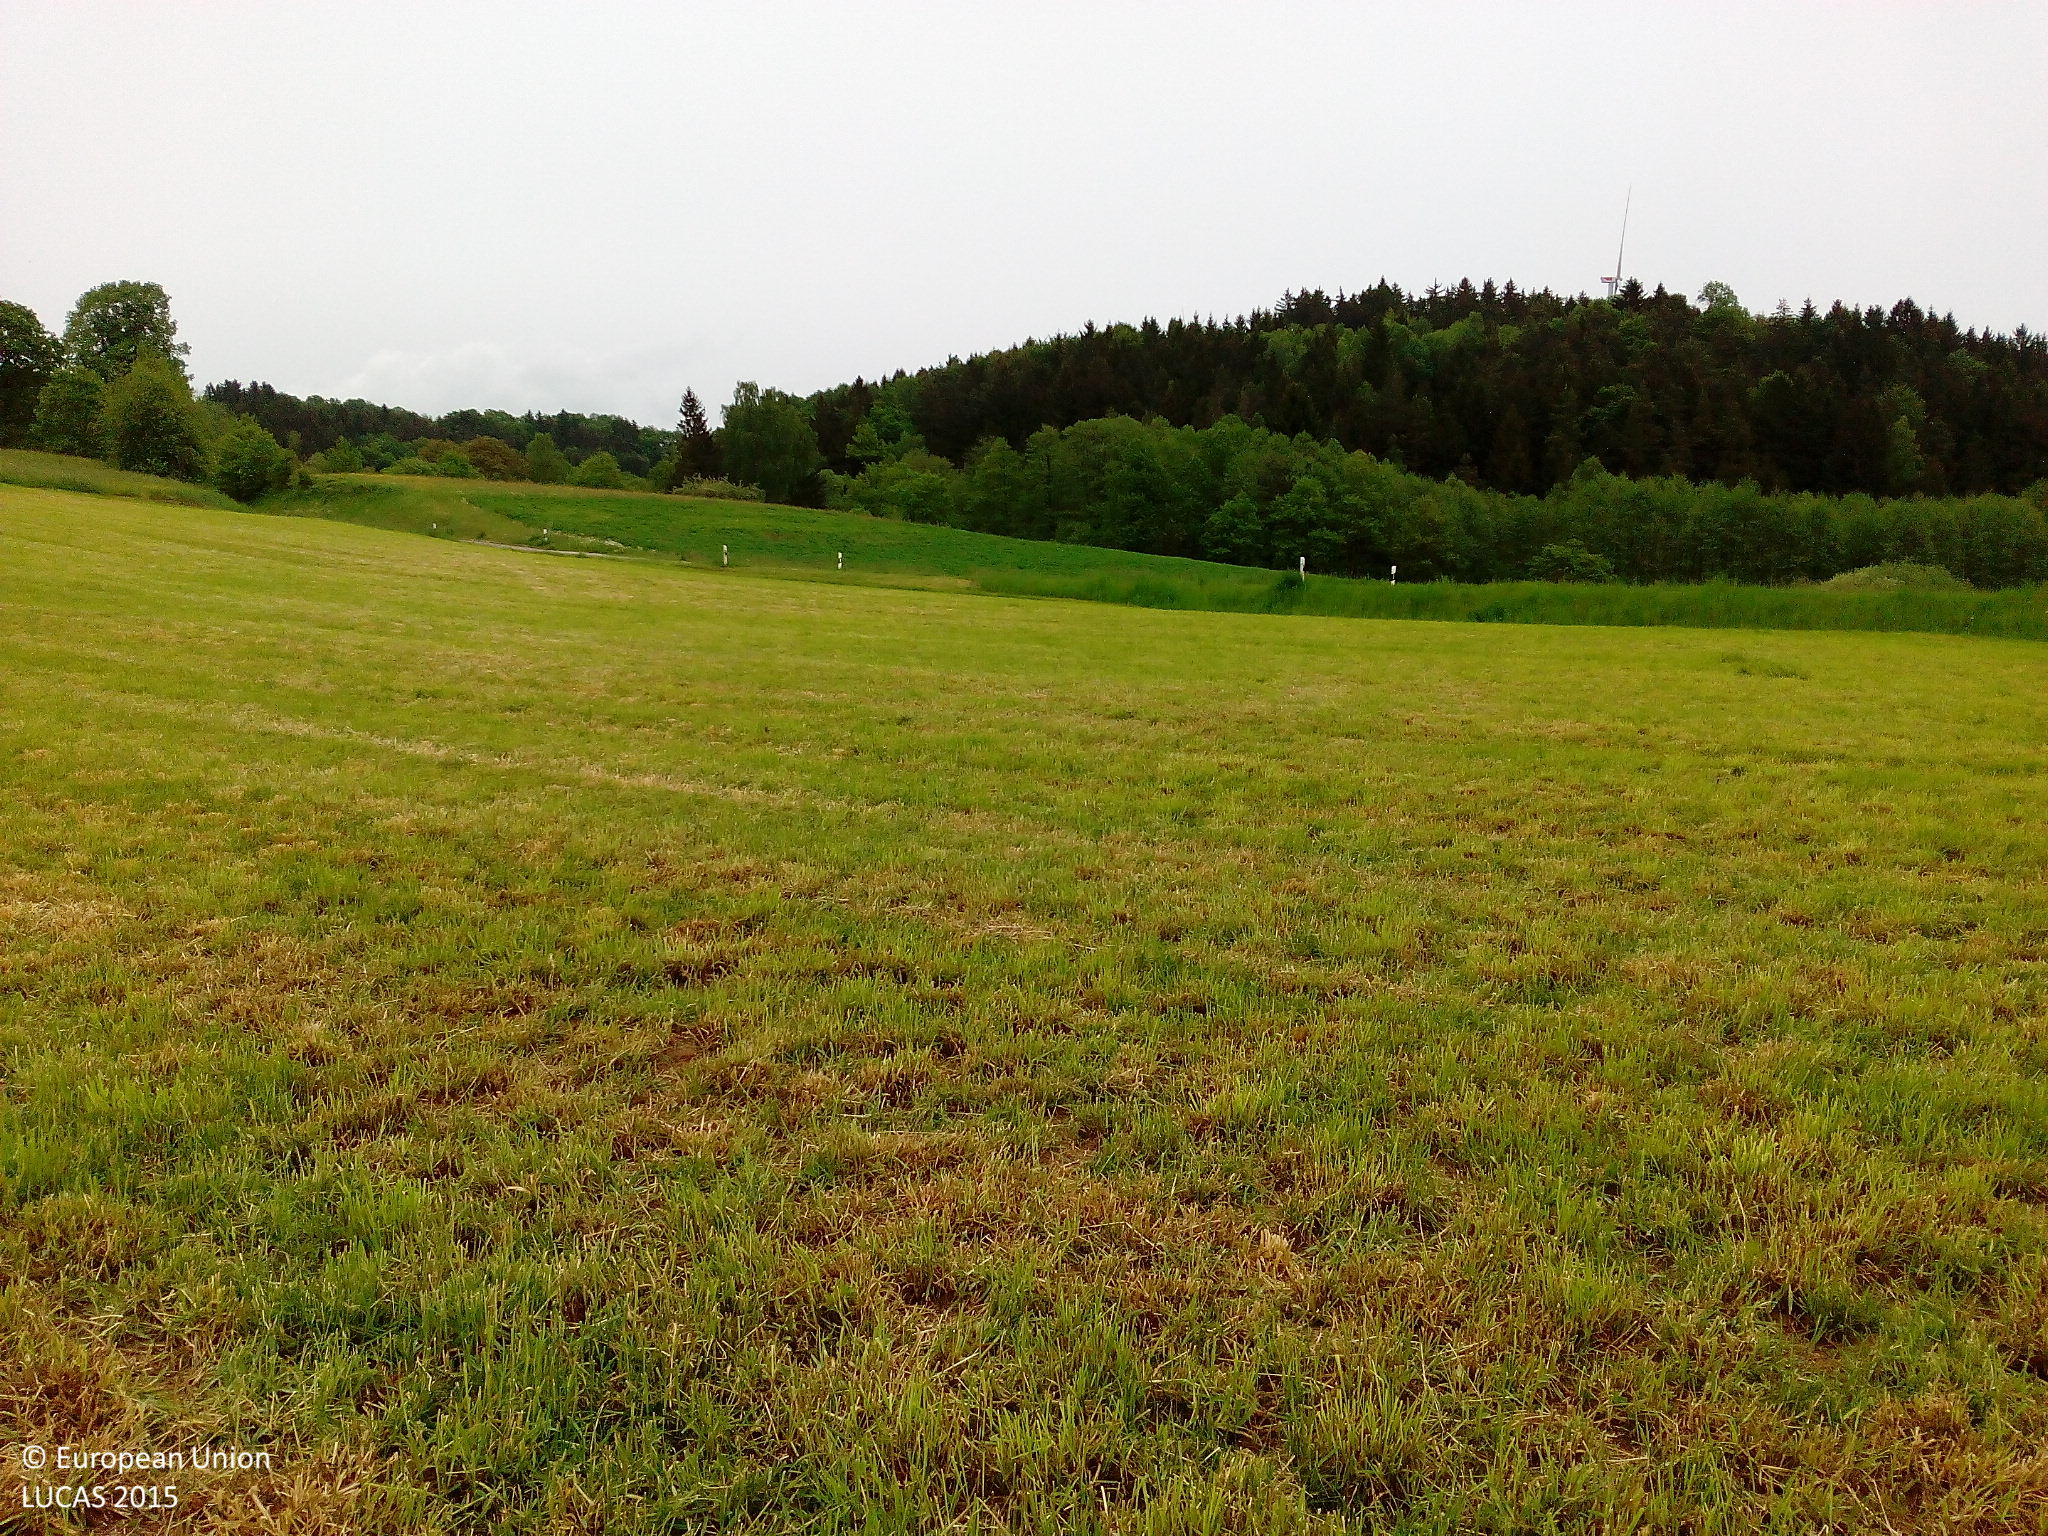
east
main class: Grassland
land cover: Grassland without tree/shrub cover
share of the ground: > 75 %
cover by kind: herbaceous plants 85 %, consolidated bare surface 15 %
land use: Agriculture (excluding fallow land and kitchen gardens)
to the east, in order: Grassland without tree/shrub cover; Paved roads, cycling and walking lanes; Grassland without tree/shrub cover; Clovers; Grassland without tree/shrub cover; Lines of trees; Grassland without tree/shrub cover; Broadleaved woodland; Tracks; Broadleaved woodland
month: May
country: DE
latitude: 49.2747
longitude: 11.5252
